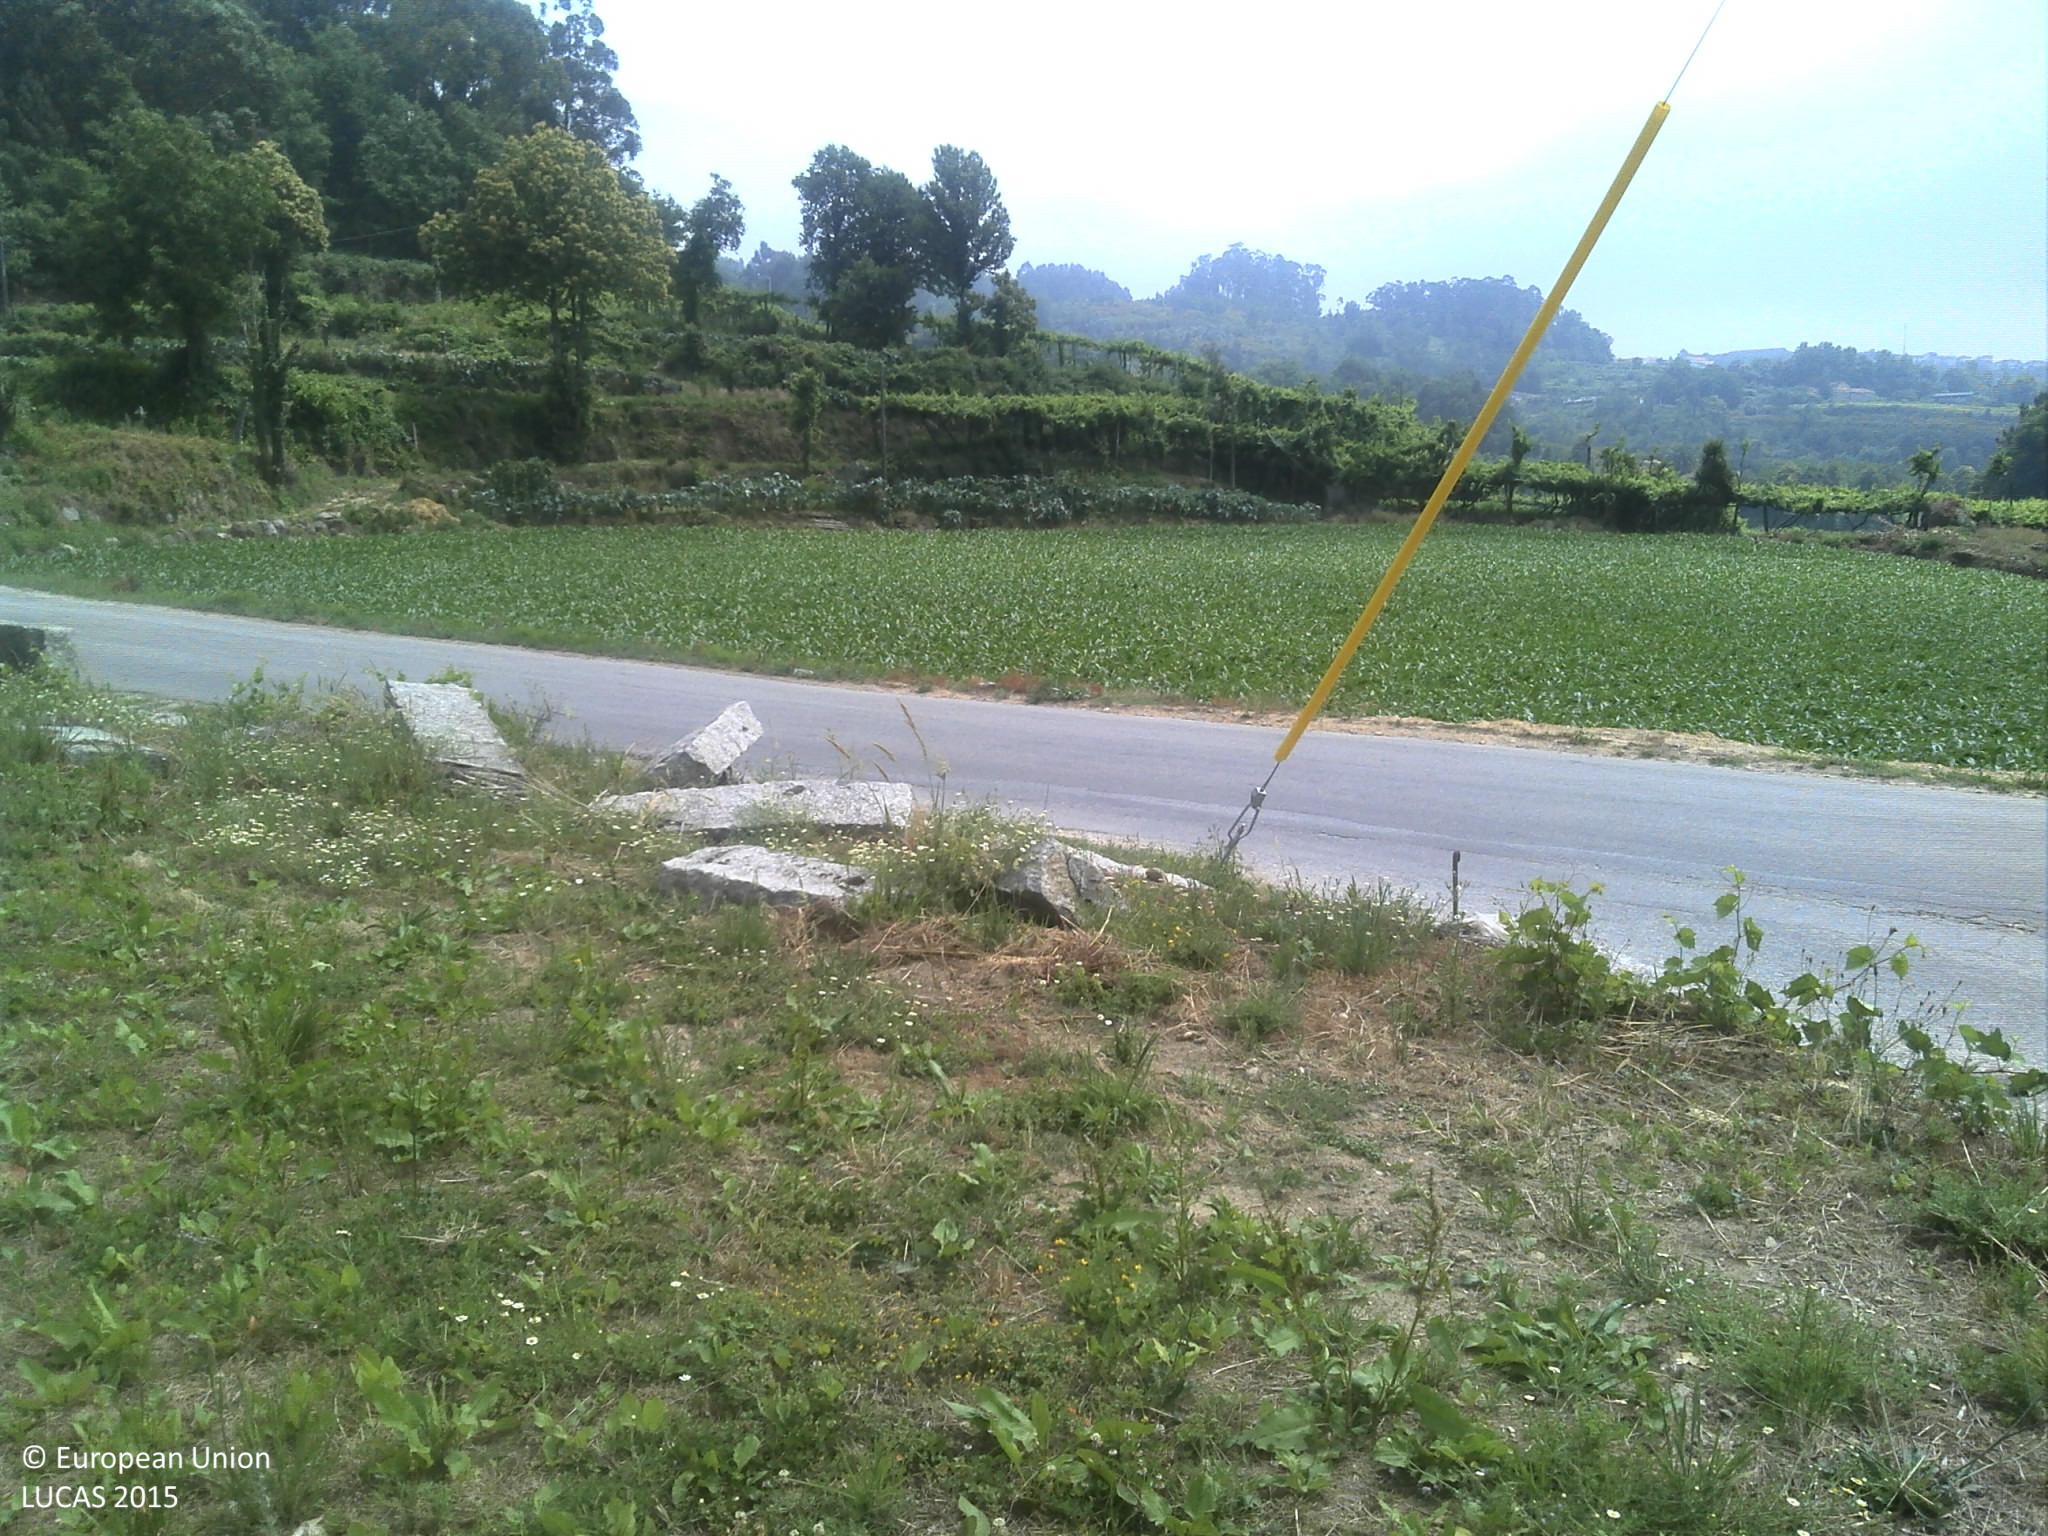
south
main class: Grassland
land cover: Spontaneously vegetated surfaces
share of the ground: 50 - 75 %
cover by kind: herbaceous plants 65 %, unconsolidated bare surface 35 %
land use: Fallow land
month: June
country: PT
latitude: 41.3262
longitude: -8.1717
